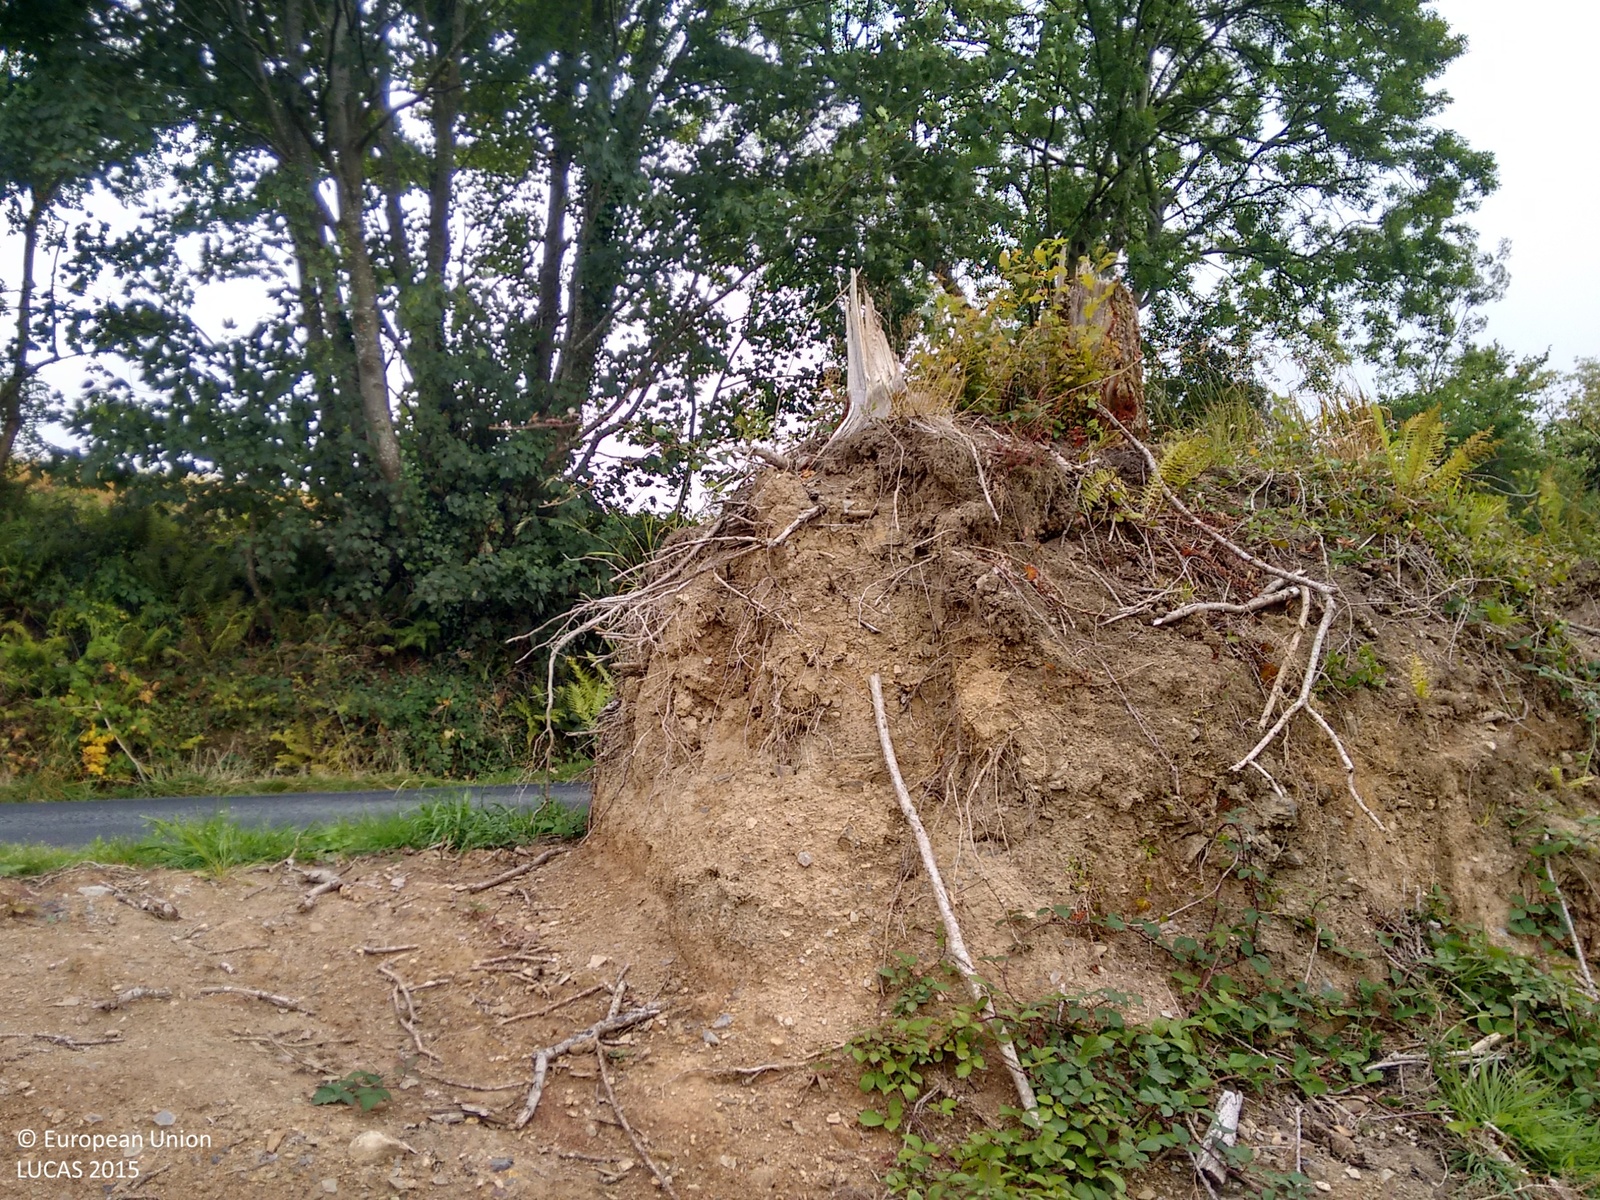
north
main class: Cropland
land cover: Barley
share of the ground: > 75 %
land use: Agriculture (excluding fallow land and kitchen gardens)
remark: Harvested field
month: August
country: IE
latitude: 52.4554
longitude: -6.5371
